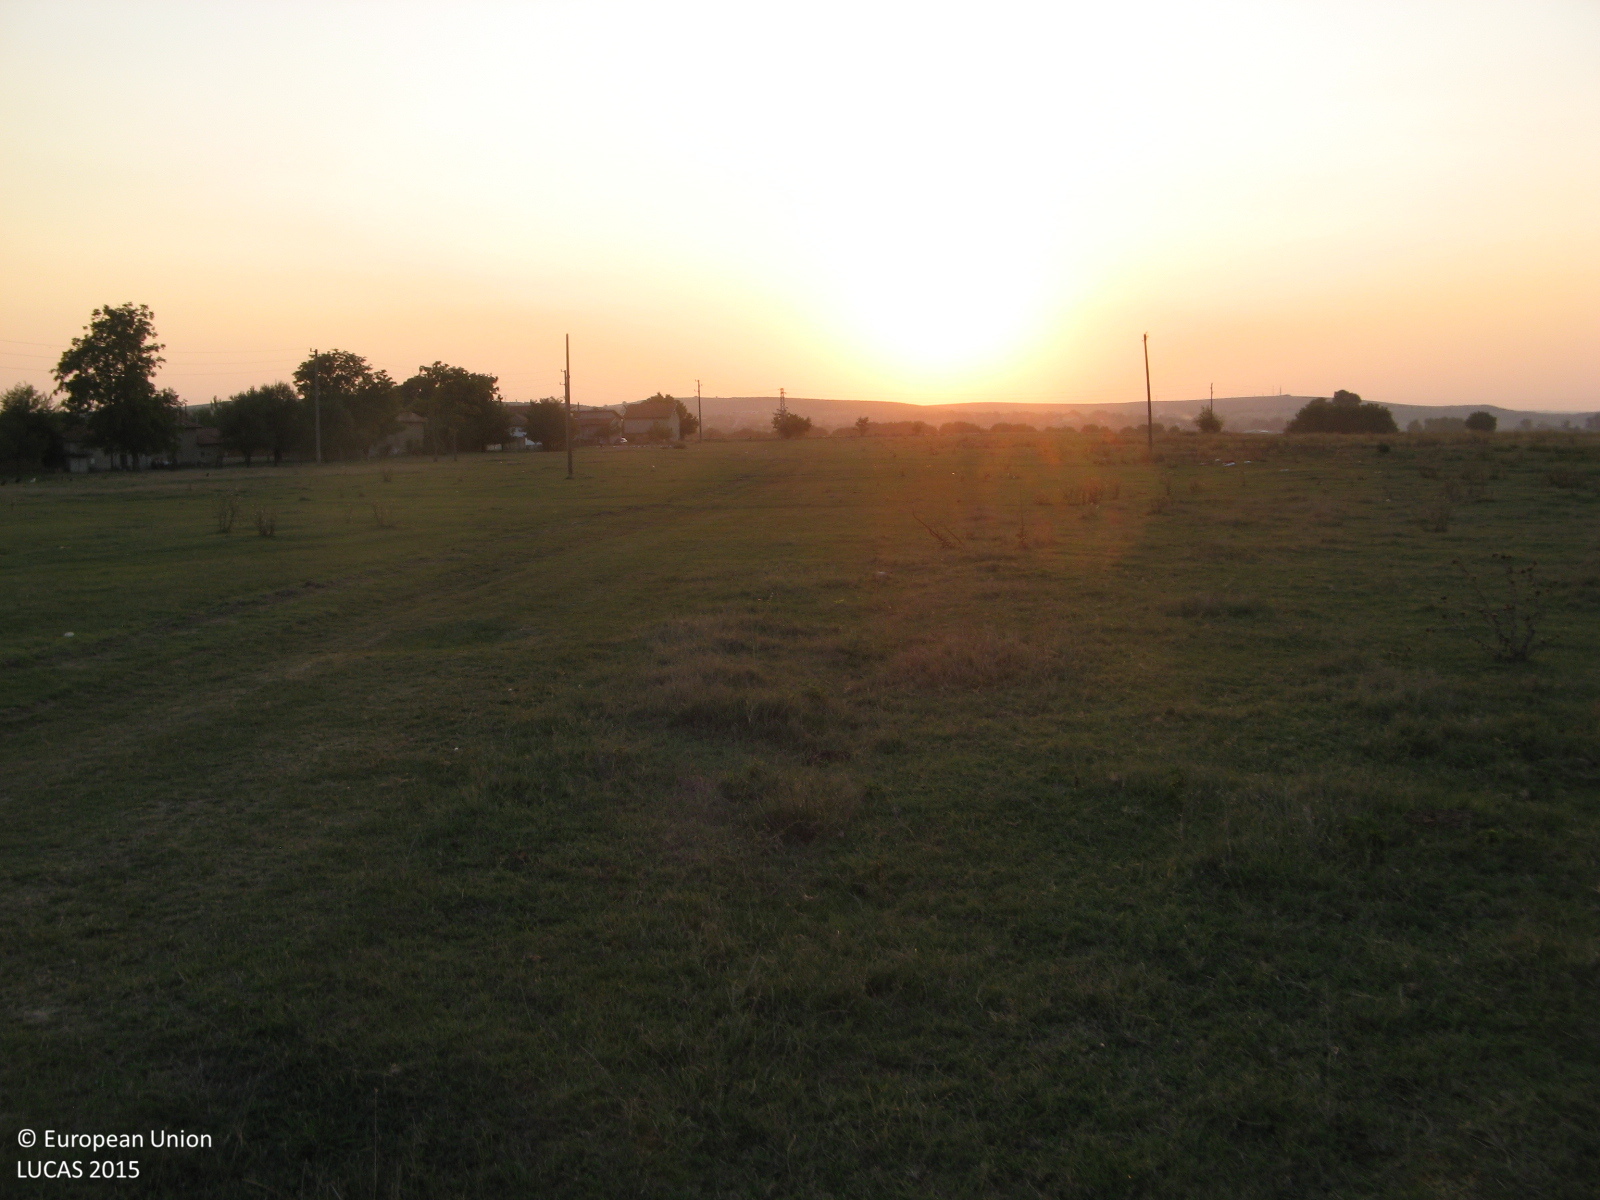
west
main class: Grassland
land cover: Grassland without tree/shrub cover
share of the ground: > 75 %
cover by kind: herbaceous plants 100 %
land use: Agriculture (excluding fallow land and kitchen gardens)
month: September
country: BG
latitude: 43.5334
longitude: 25.6900
